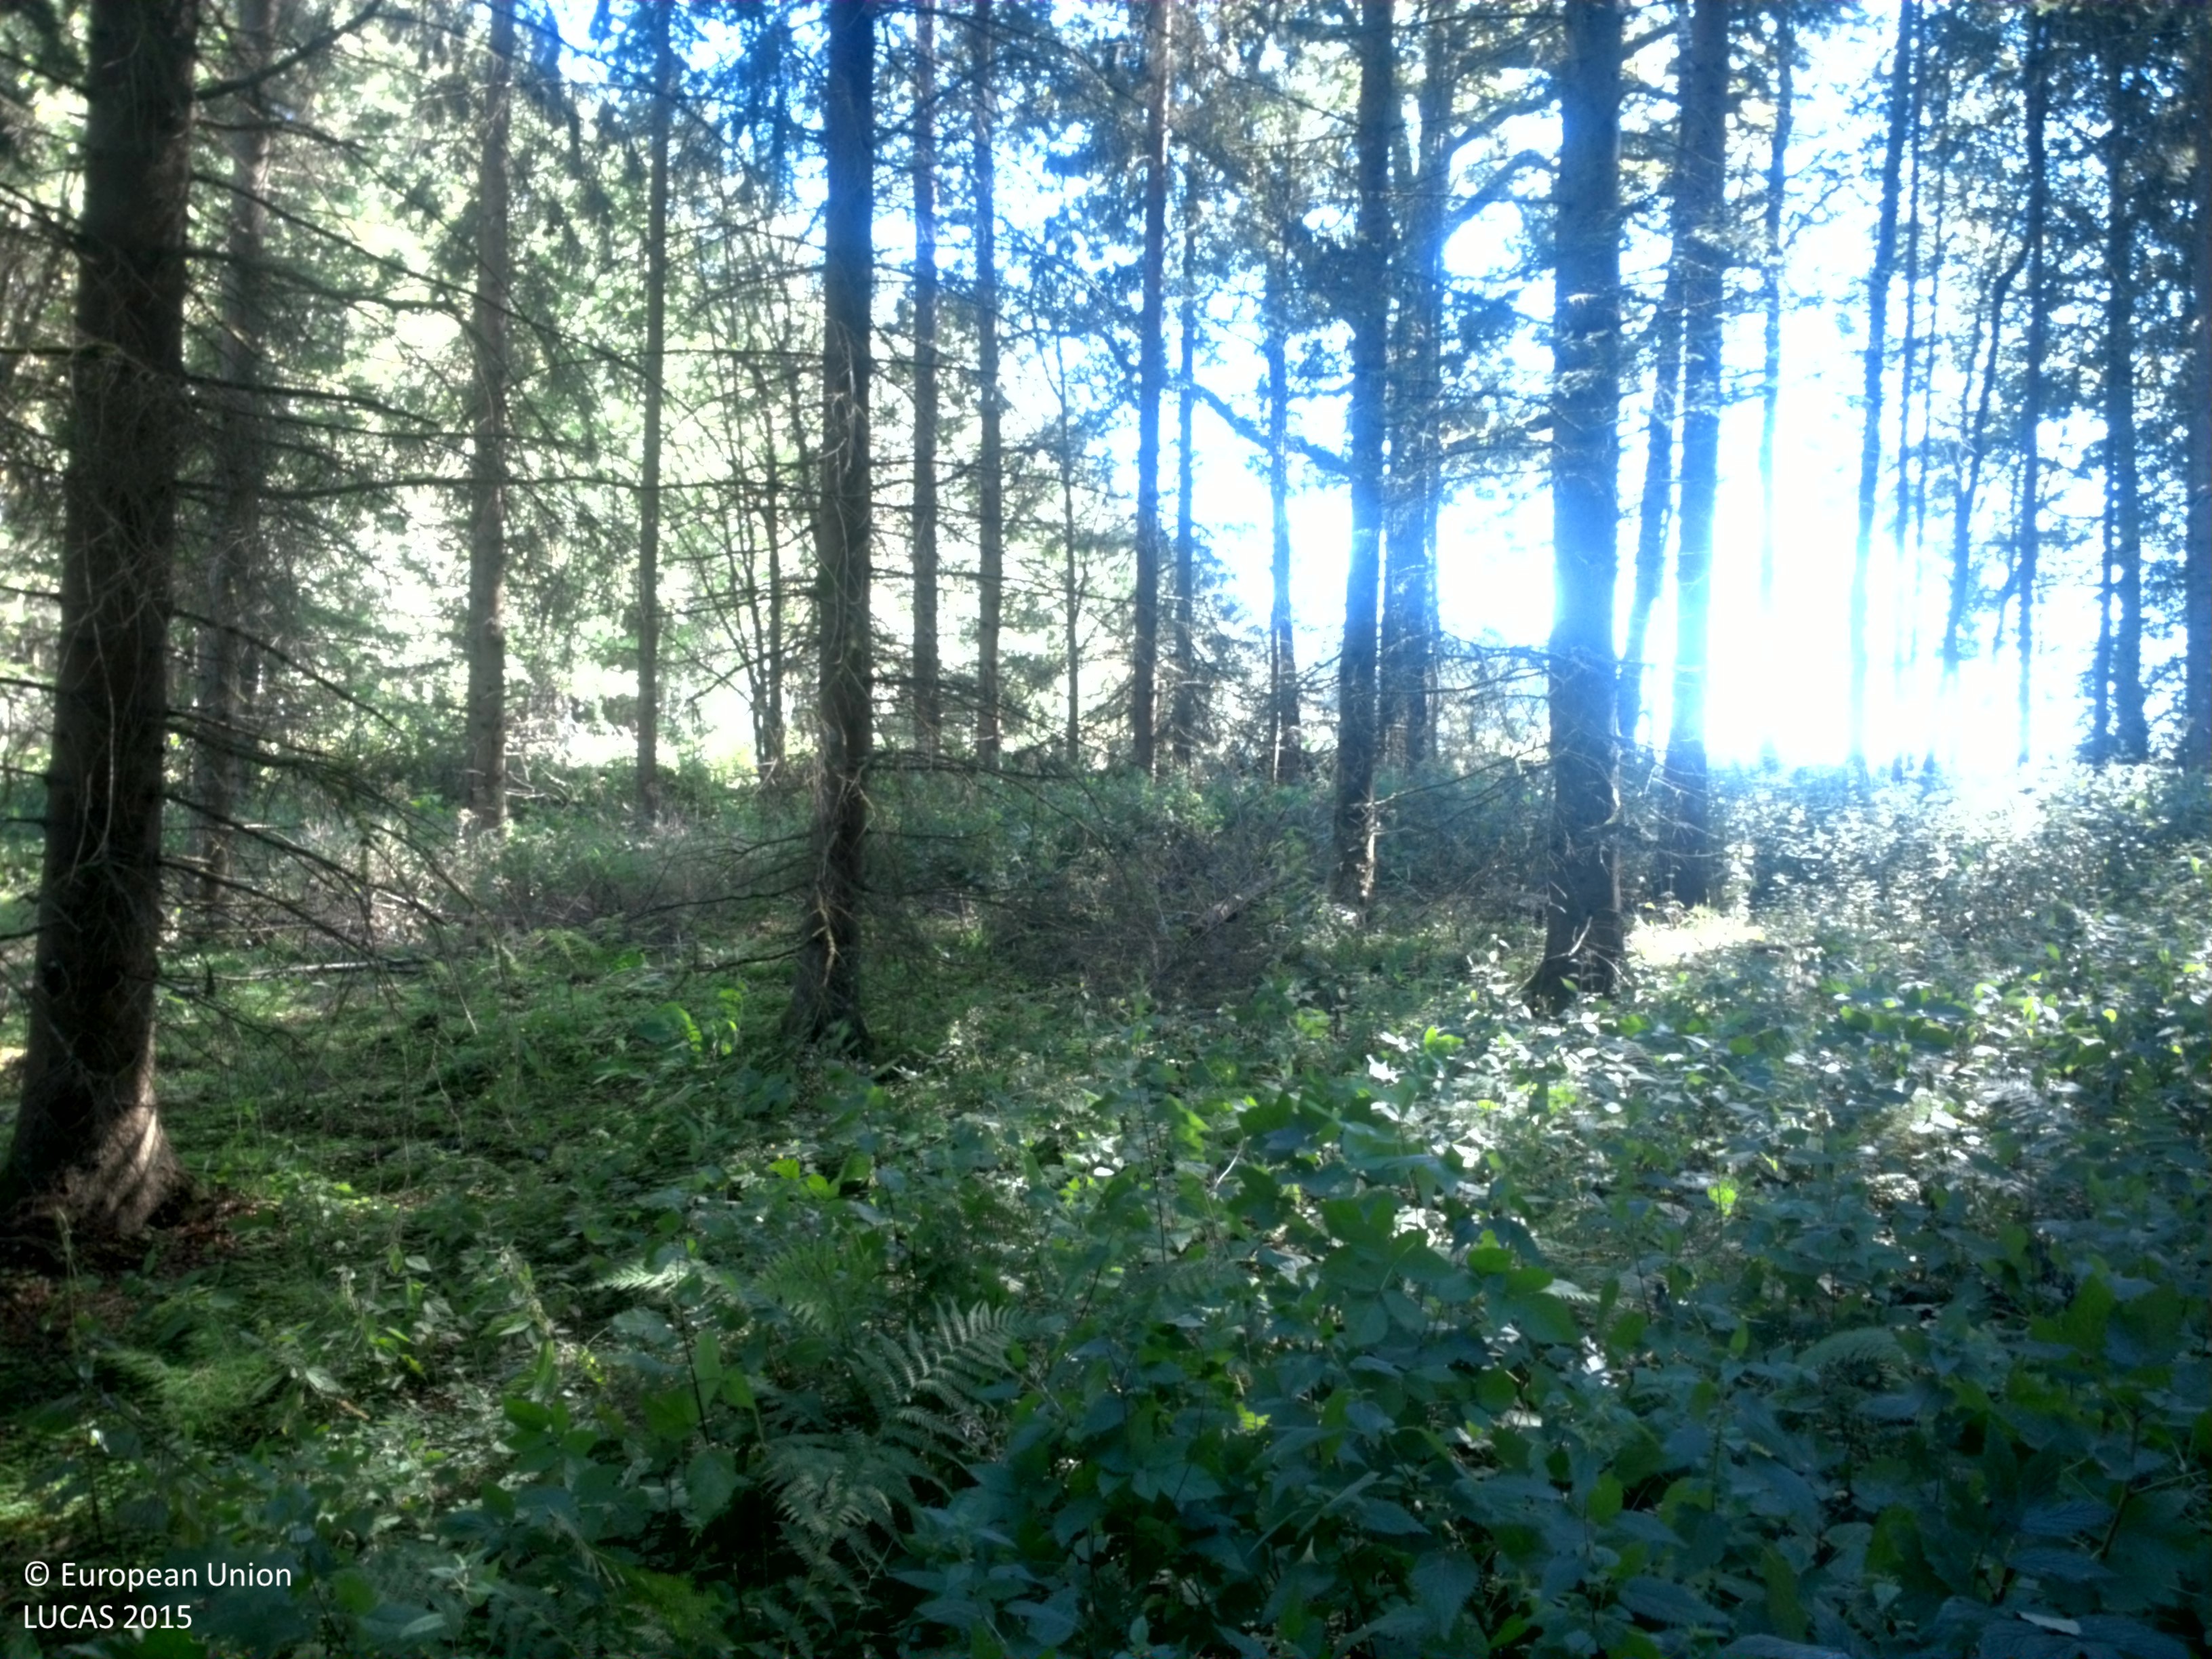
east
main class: Woodland
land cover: Spruce dominated coniferous woodland
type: boreal forest
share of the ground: 50 - 75 %
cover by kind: coniferous forest trees 55 %, herbaceous plants 30 %, lichens and mosses 10 %, broadleaved forest trees 5 %
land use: Forestry
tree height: > 5 m
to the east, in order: Spruce dominated coniferous woodland; Dry stone walls; Grassland without tree/shrub cover; Fences; Dry stone walls; Spruce dominated mixed woodland; Electric lines; Spruce dominated coniferous woodland; Fences; Grassland without tree/shrub cover; Fences; Grassland without tree/shrub cover; Fences; Grassland with sparse tree/shrub cover
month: August
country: SE
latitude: 57.9992
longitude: 13.2941
